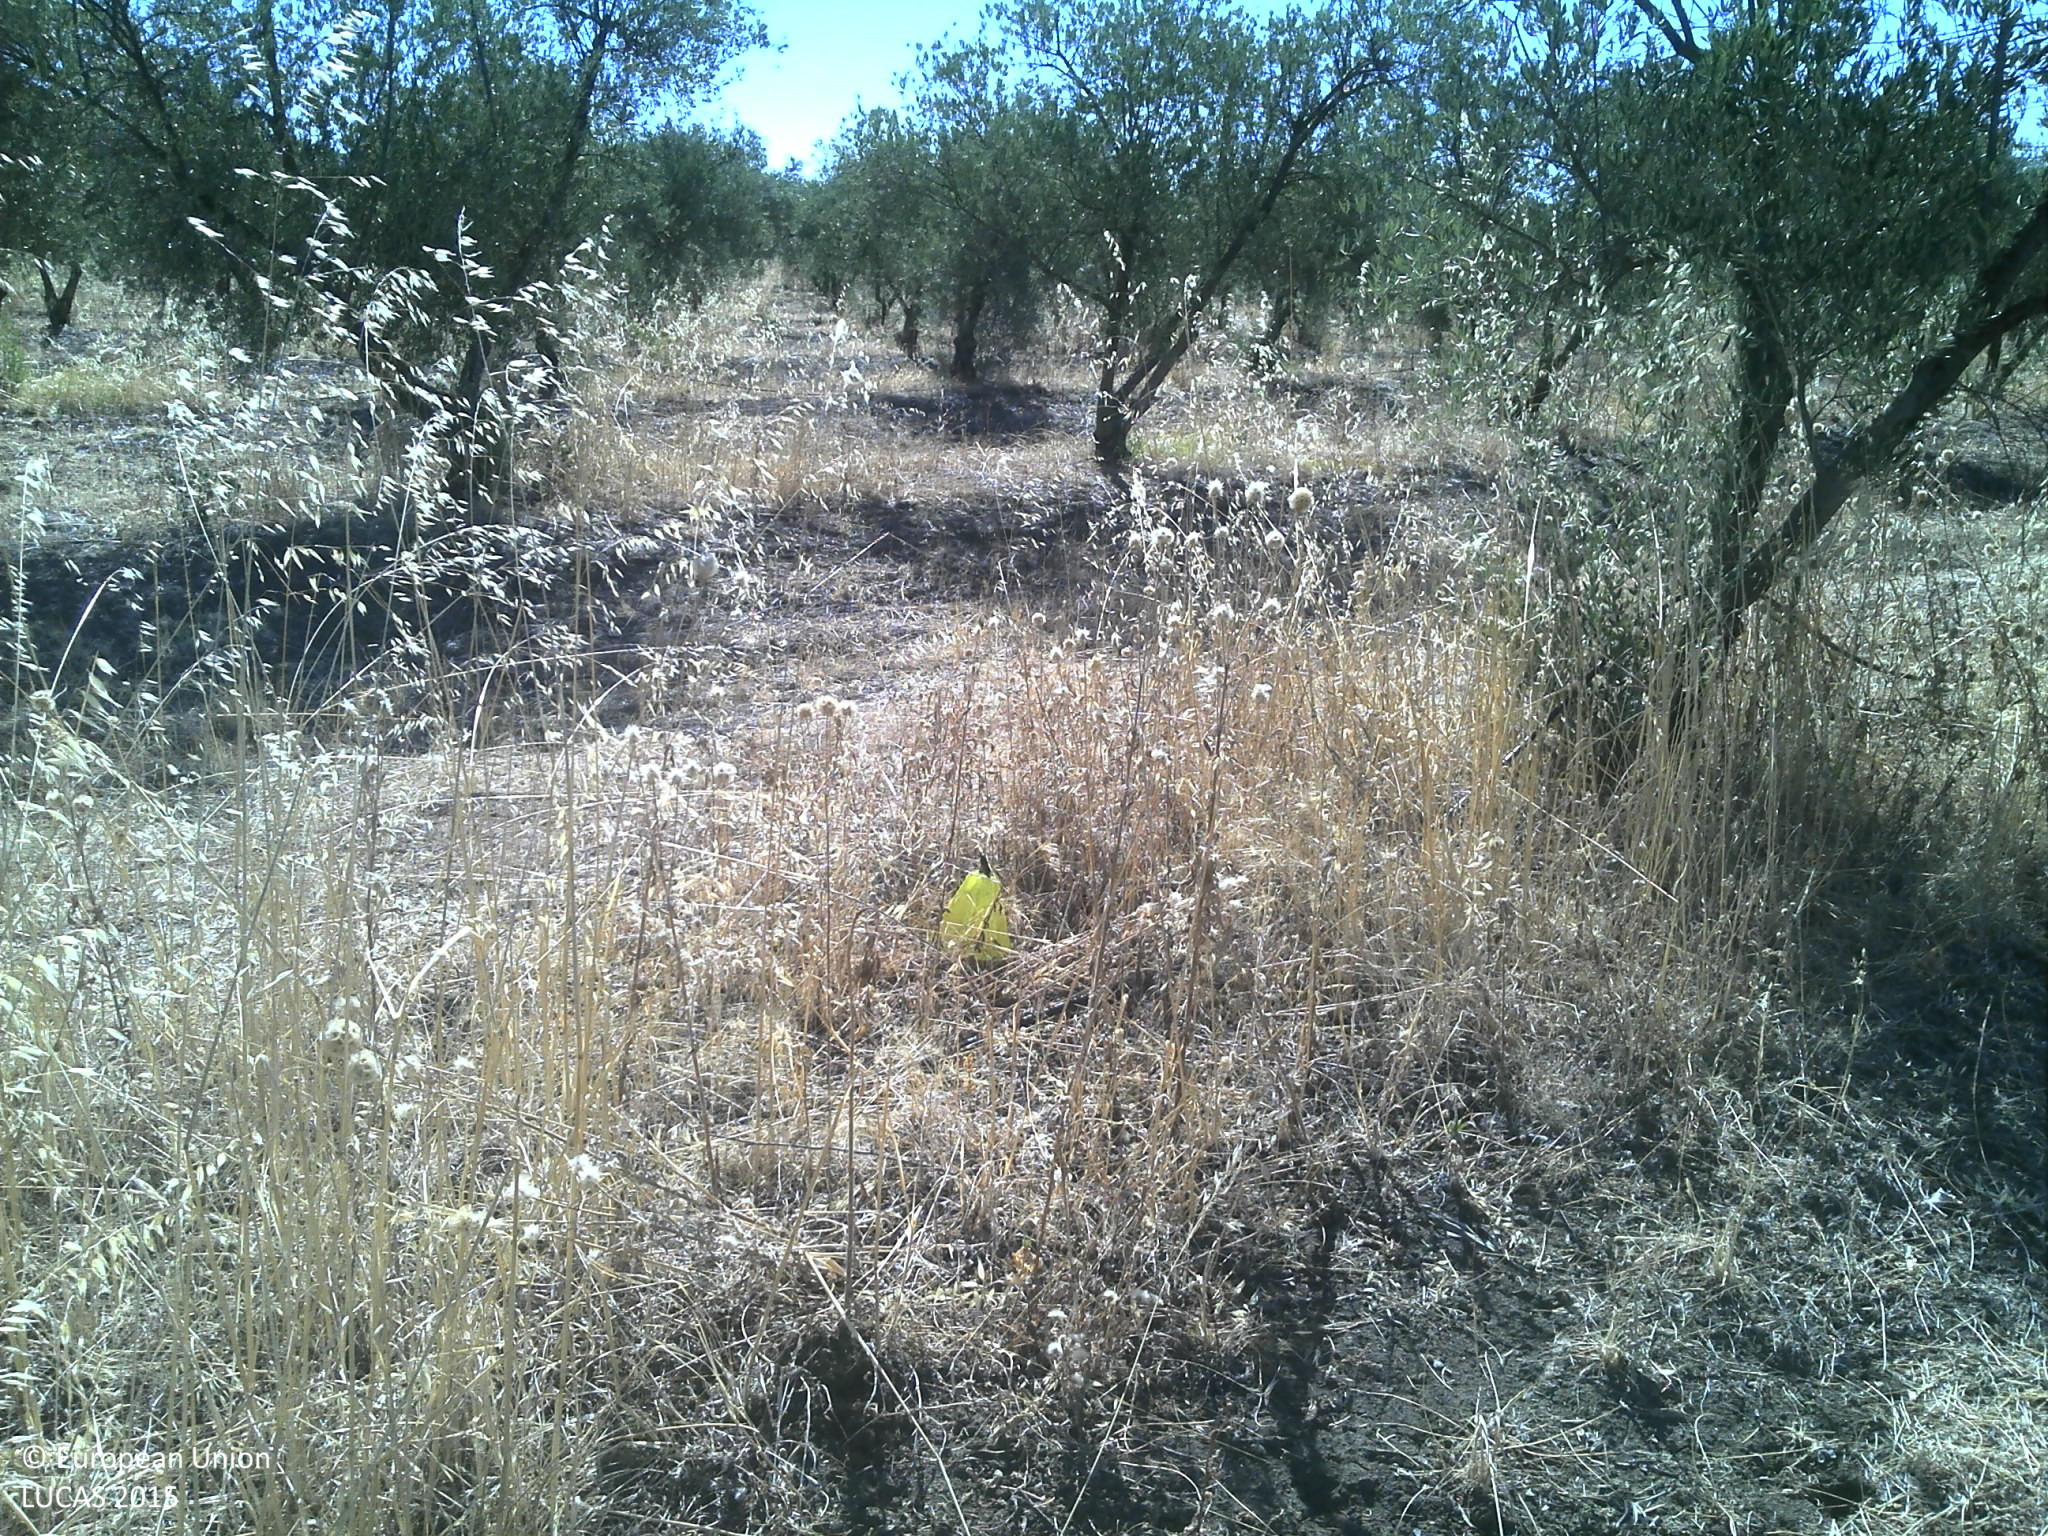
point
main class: Cropland
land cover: Olive groves
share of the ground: 50 - 75 %
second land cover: Grassland without tree/shrub cover
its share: 10 - 25 %
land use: Agriculture (excluding fallow land and kitchen gardens)
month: July
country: PT
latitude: 39.0318
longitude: -7.0912
